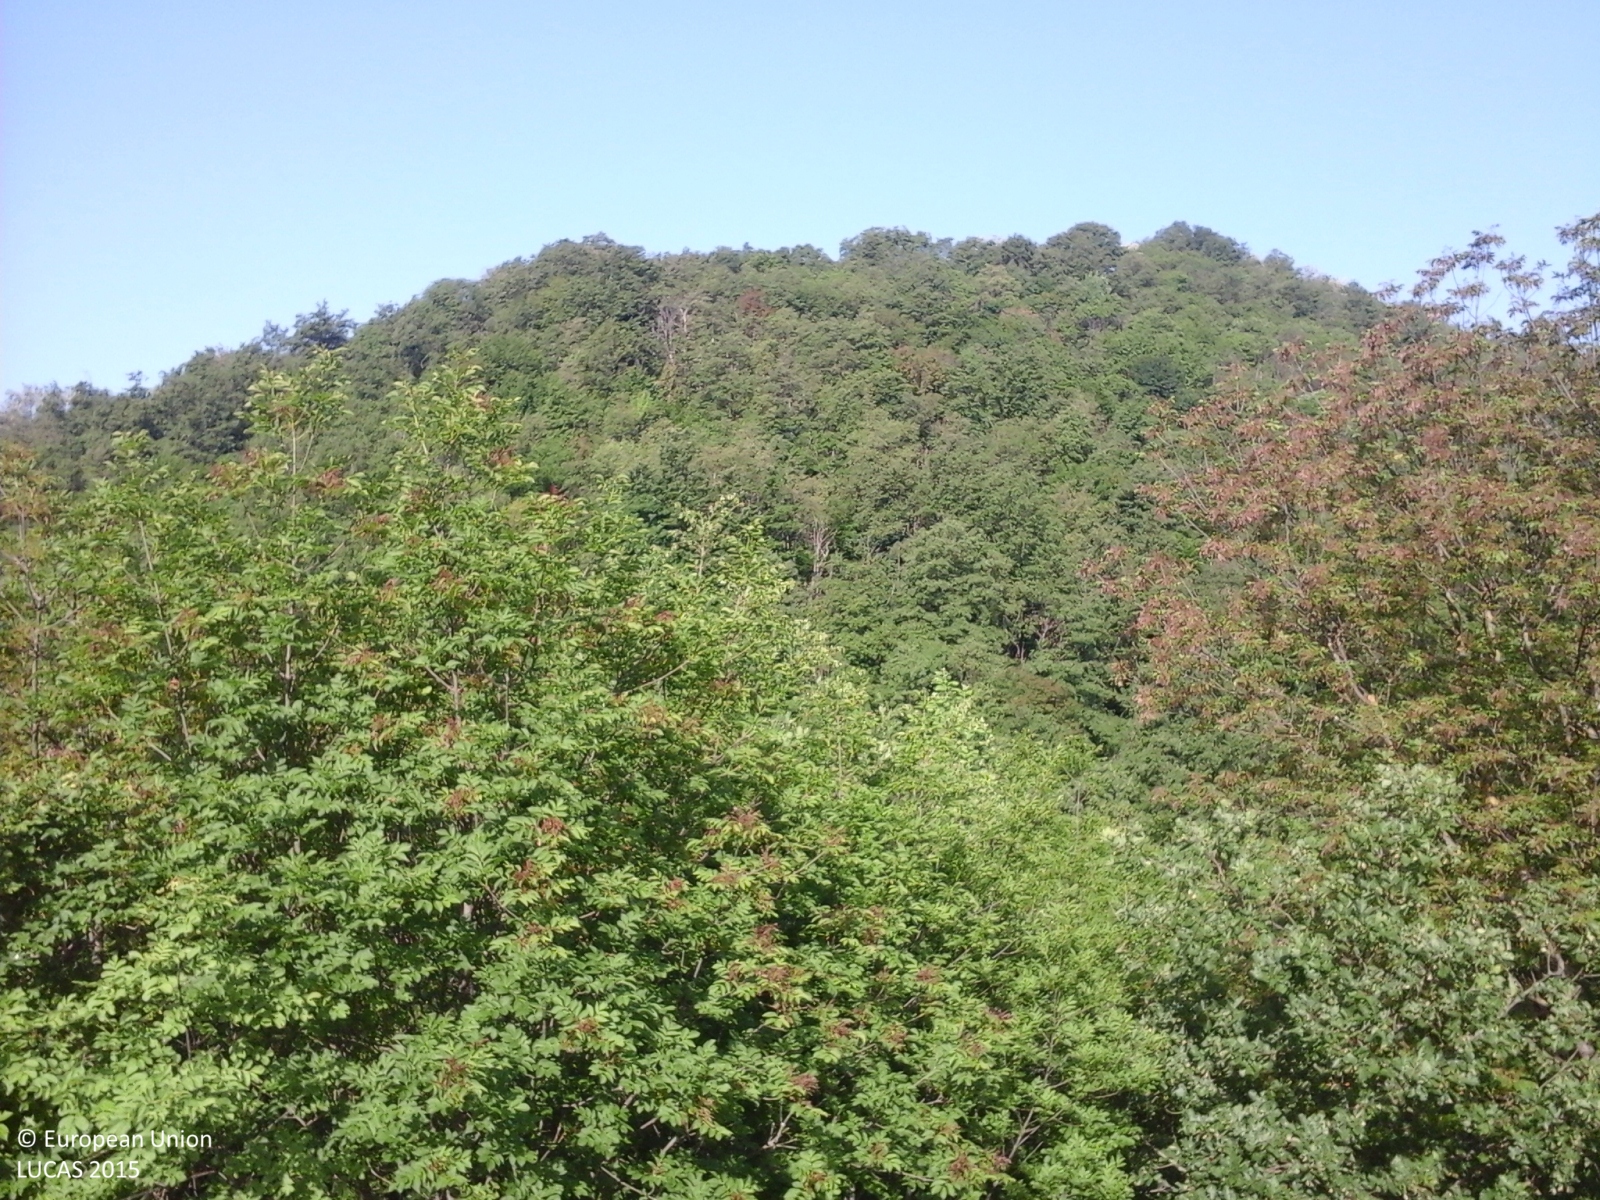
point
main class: Woodland
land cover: Broadleaved woodland
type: mesophytic deciduous forest
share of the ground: > 75 %
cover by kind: broadleaved forest trees 100 %
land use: Forestry
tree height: > 5 m
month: May
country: IT
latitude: 44.4371
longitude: 10.8649
